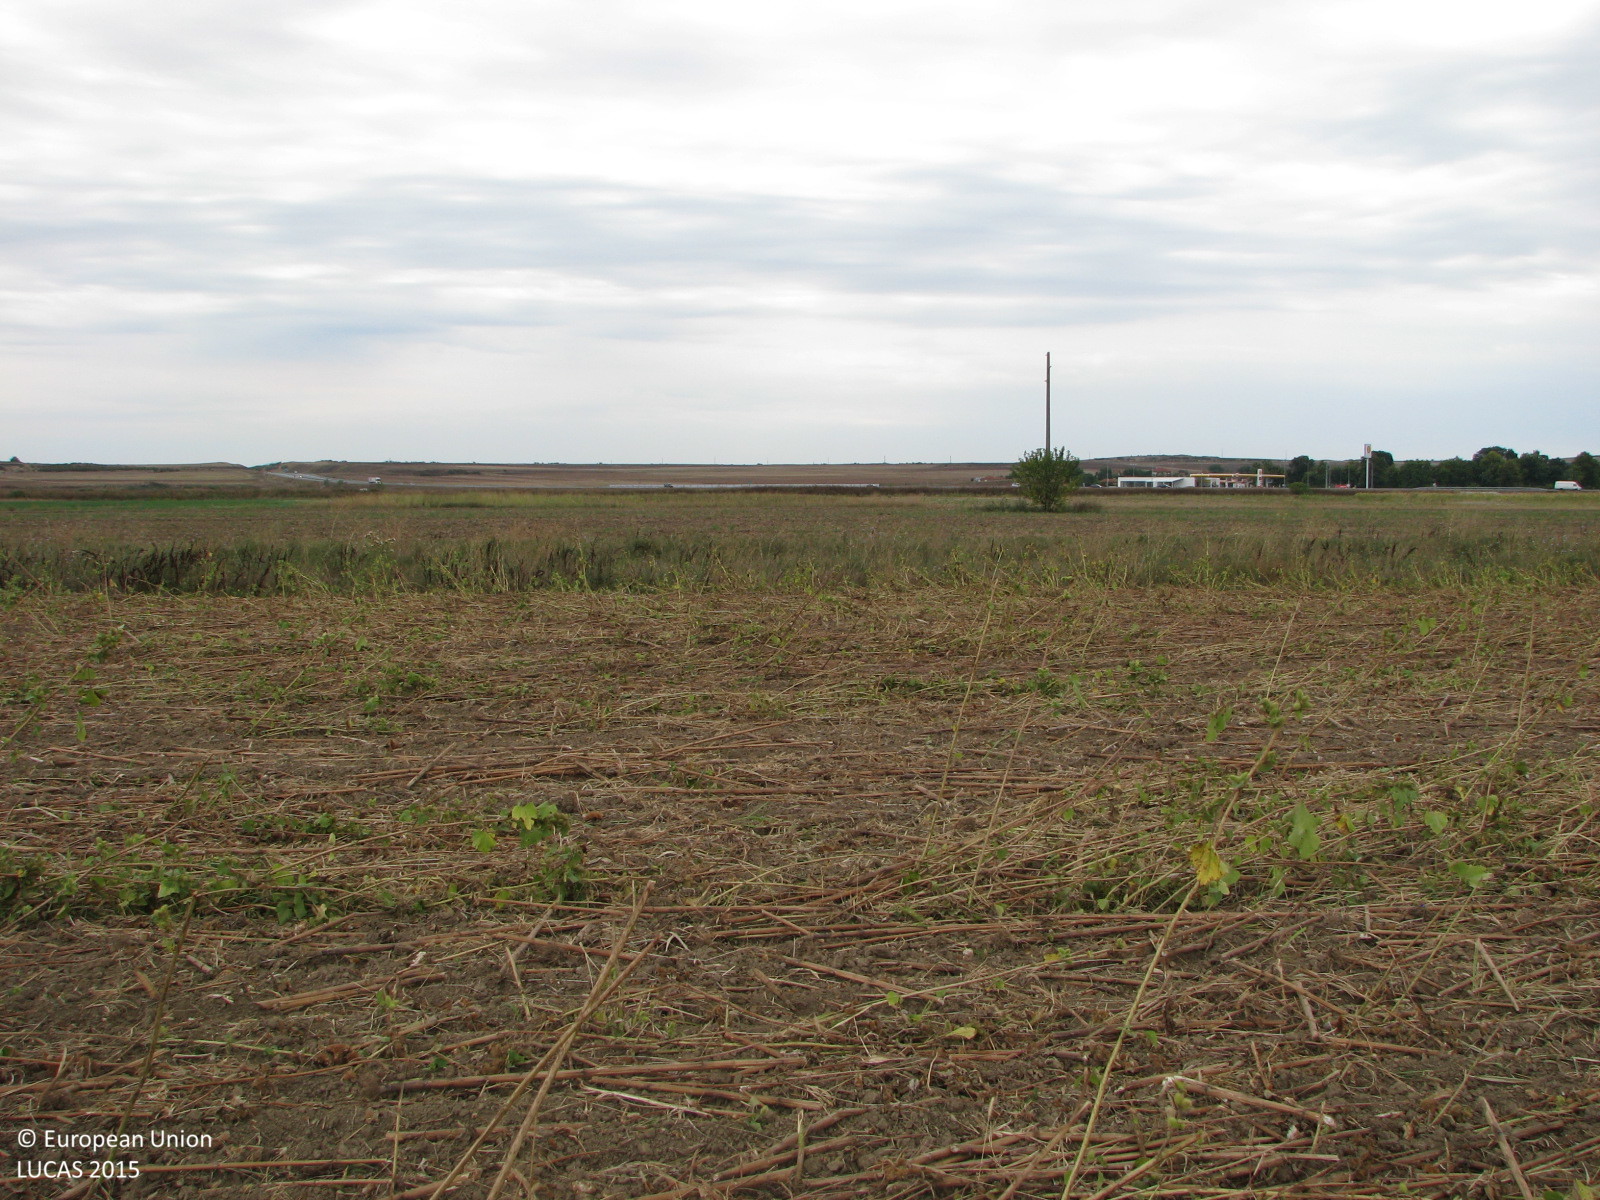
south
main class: Cropland
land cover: Sunflower
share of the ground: < 10 %
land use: Agriculture (excluding fallow land and kitchen gardens)
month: September
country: BG
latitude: 42.5493
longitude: 26.4469
